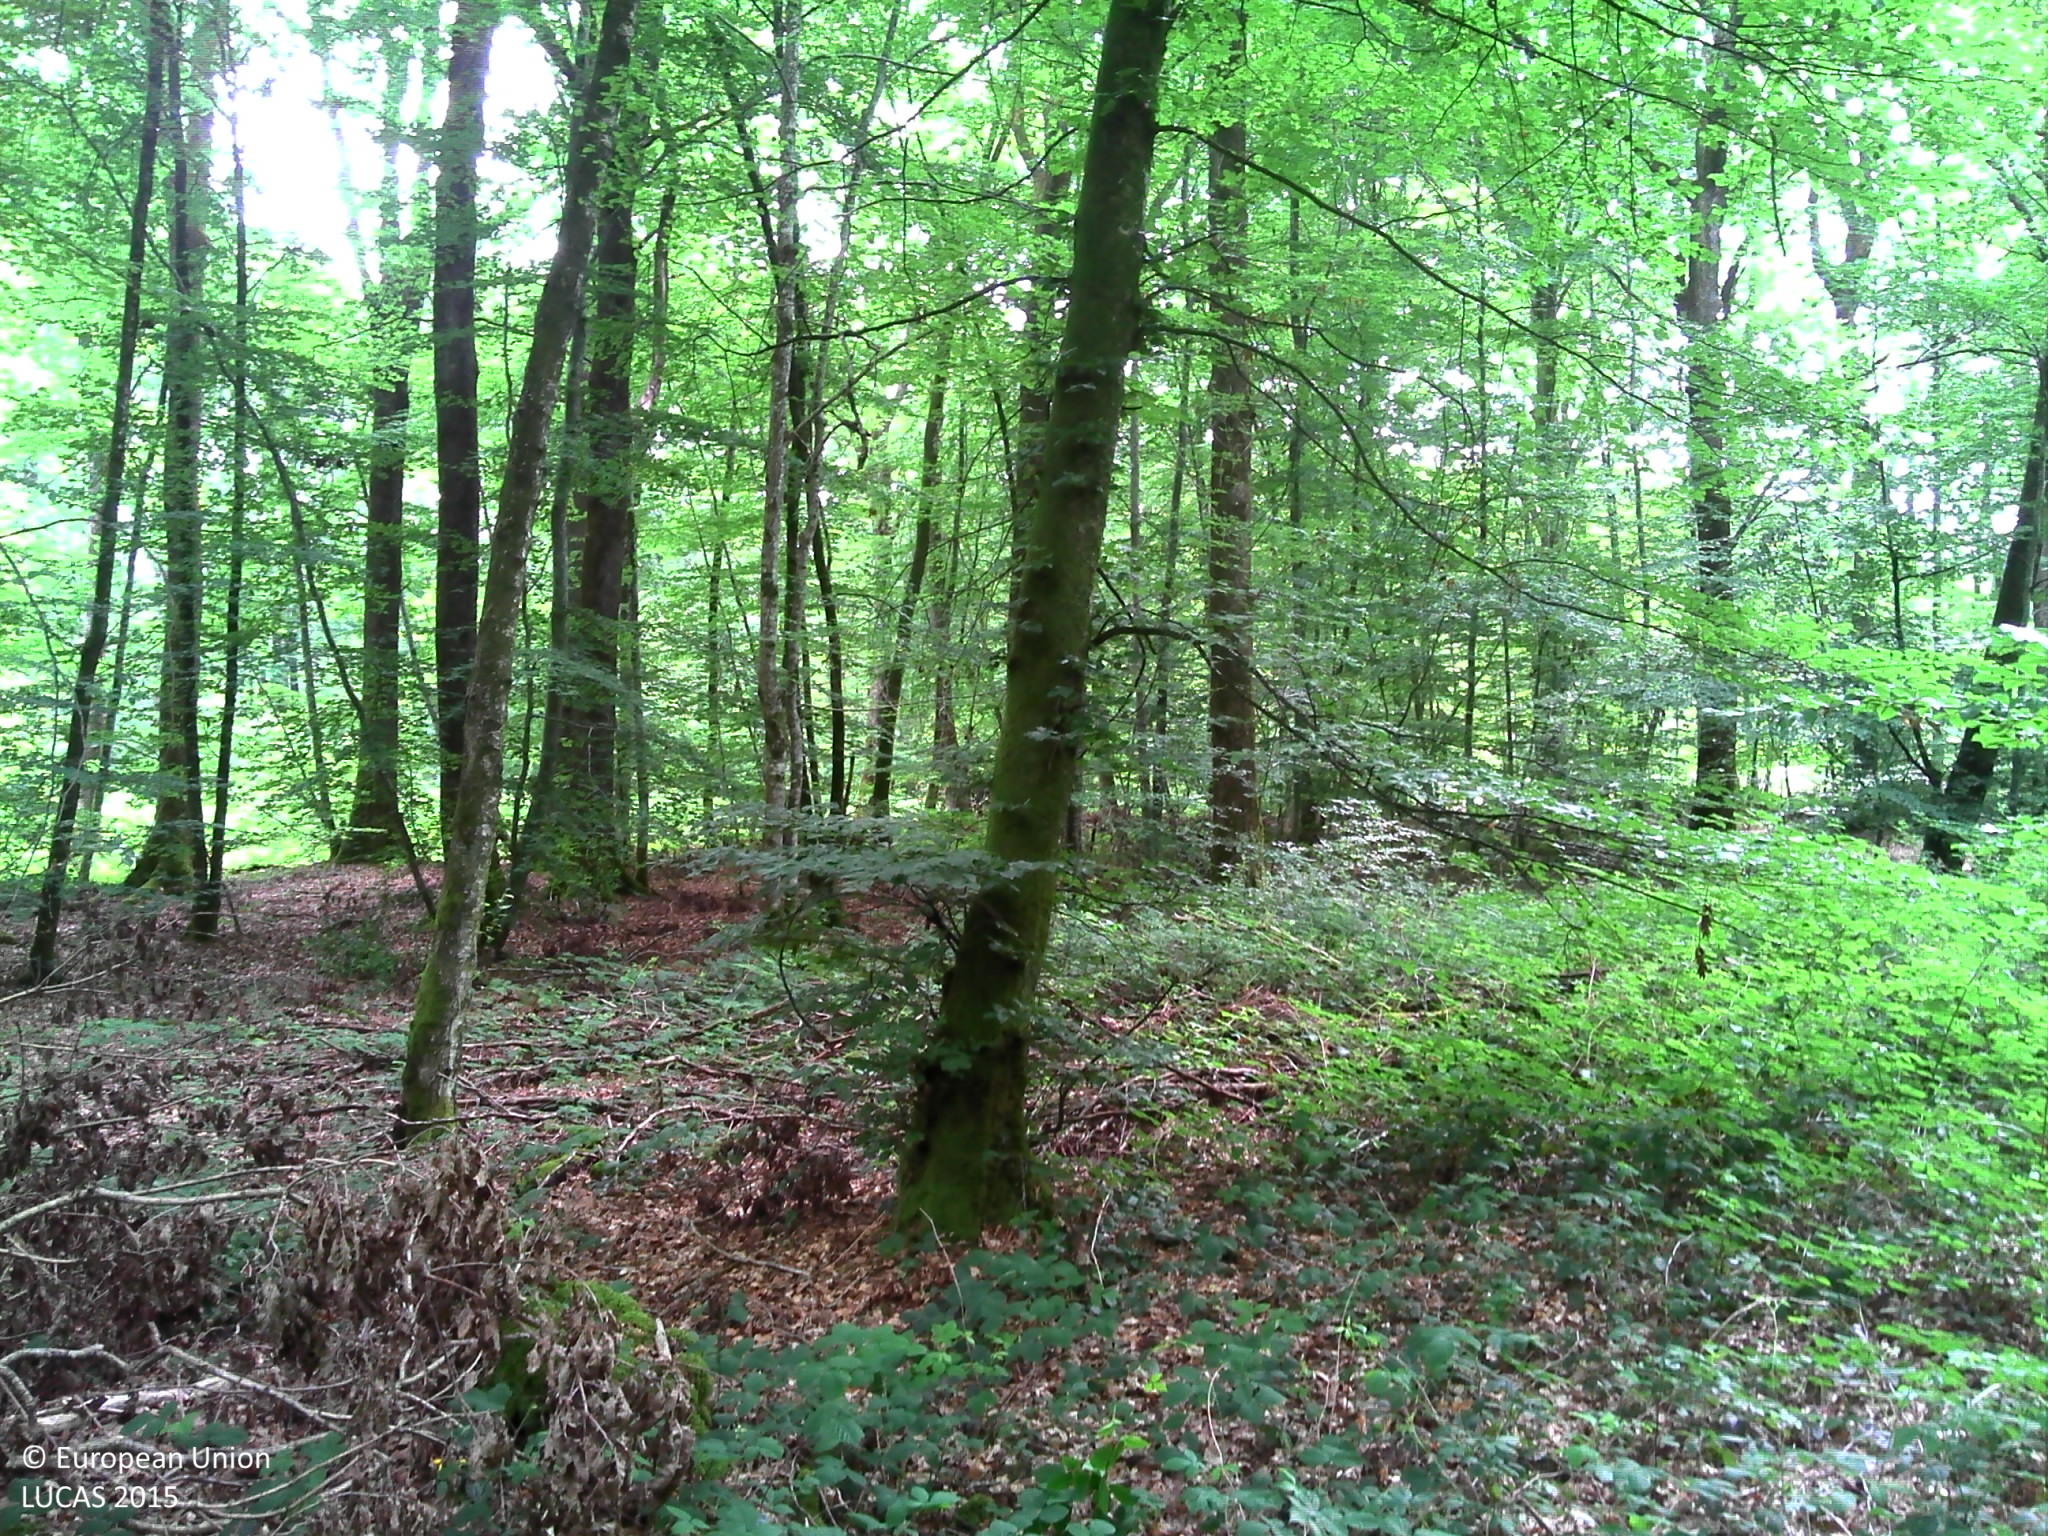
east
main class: Woodland
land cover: Broadleaved woodland
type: acidophilous oak and oak-birch forest
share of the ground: > 75 %
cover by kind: broadleaved forest trees 90 %, shrubs 5 %, lichens and mosses 5 %
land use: Forestry
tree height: > 5 m
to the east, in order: Broadleaved woodland; Ditches and canals; Grass margins; Paved roads, cycling and walking lanes; Grass margins; Ditches and canals; Broadleaved woodland; Ditches and canals; Grass margins; Paved roads, cycling and walking lanes; Grass margins; Ditches and canals; Broadleaved woodland
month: June
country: FR
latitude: 47.1615
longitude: 3.1497
